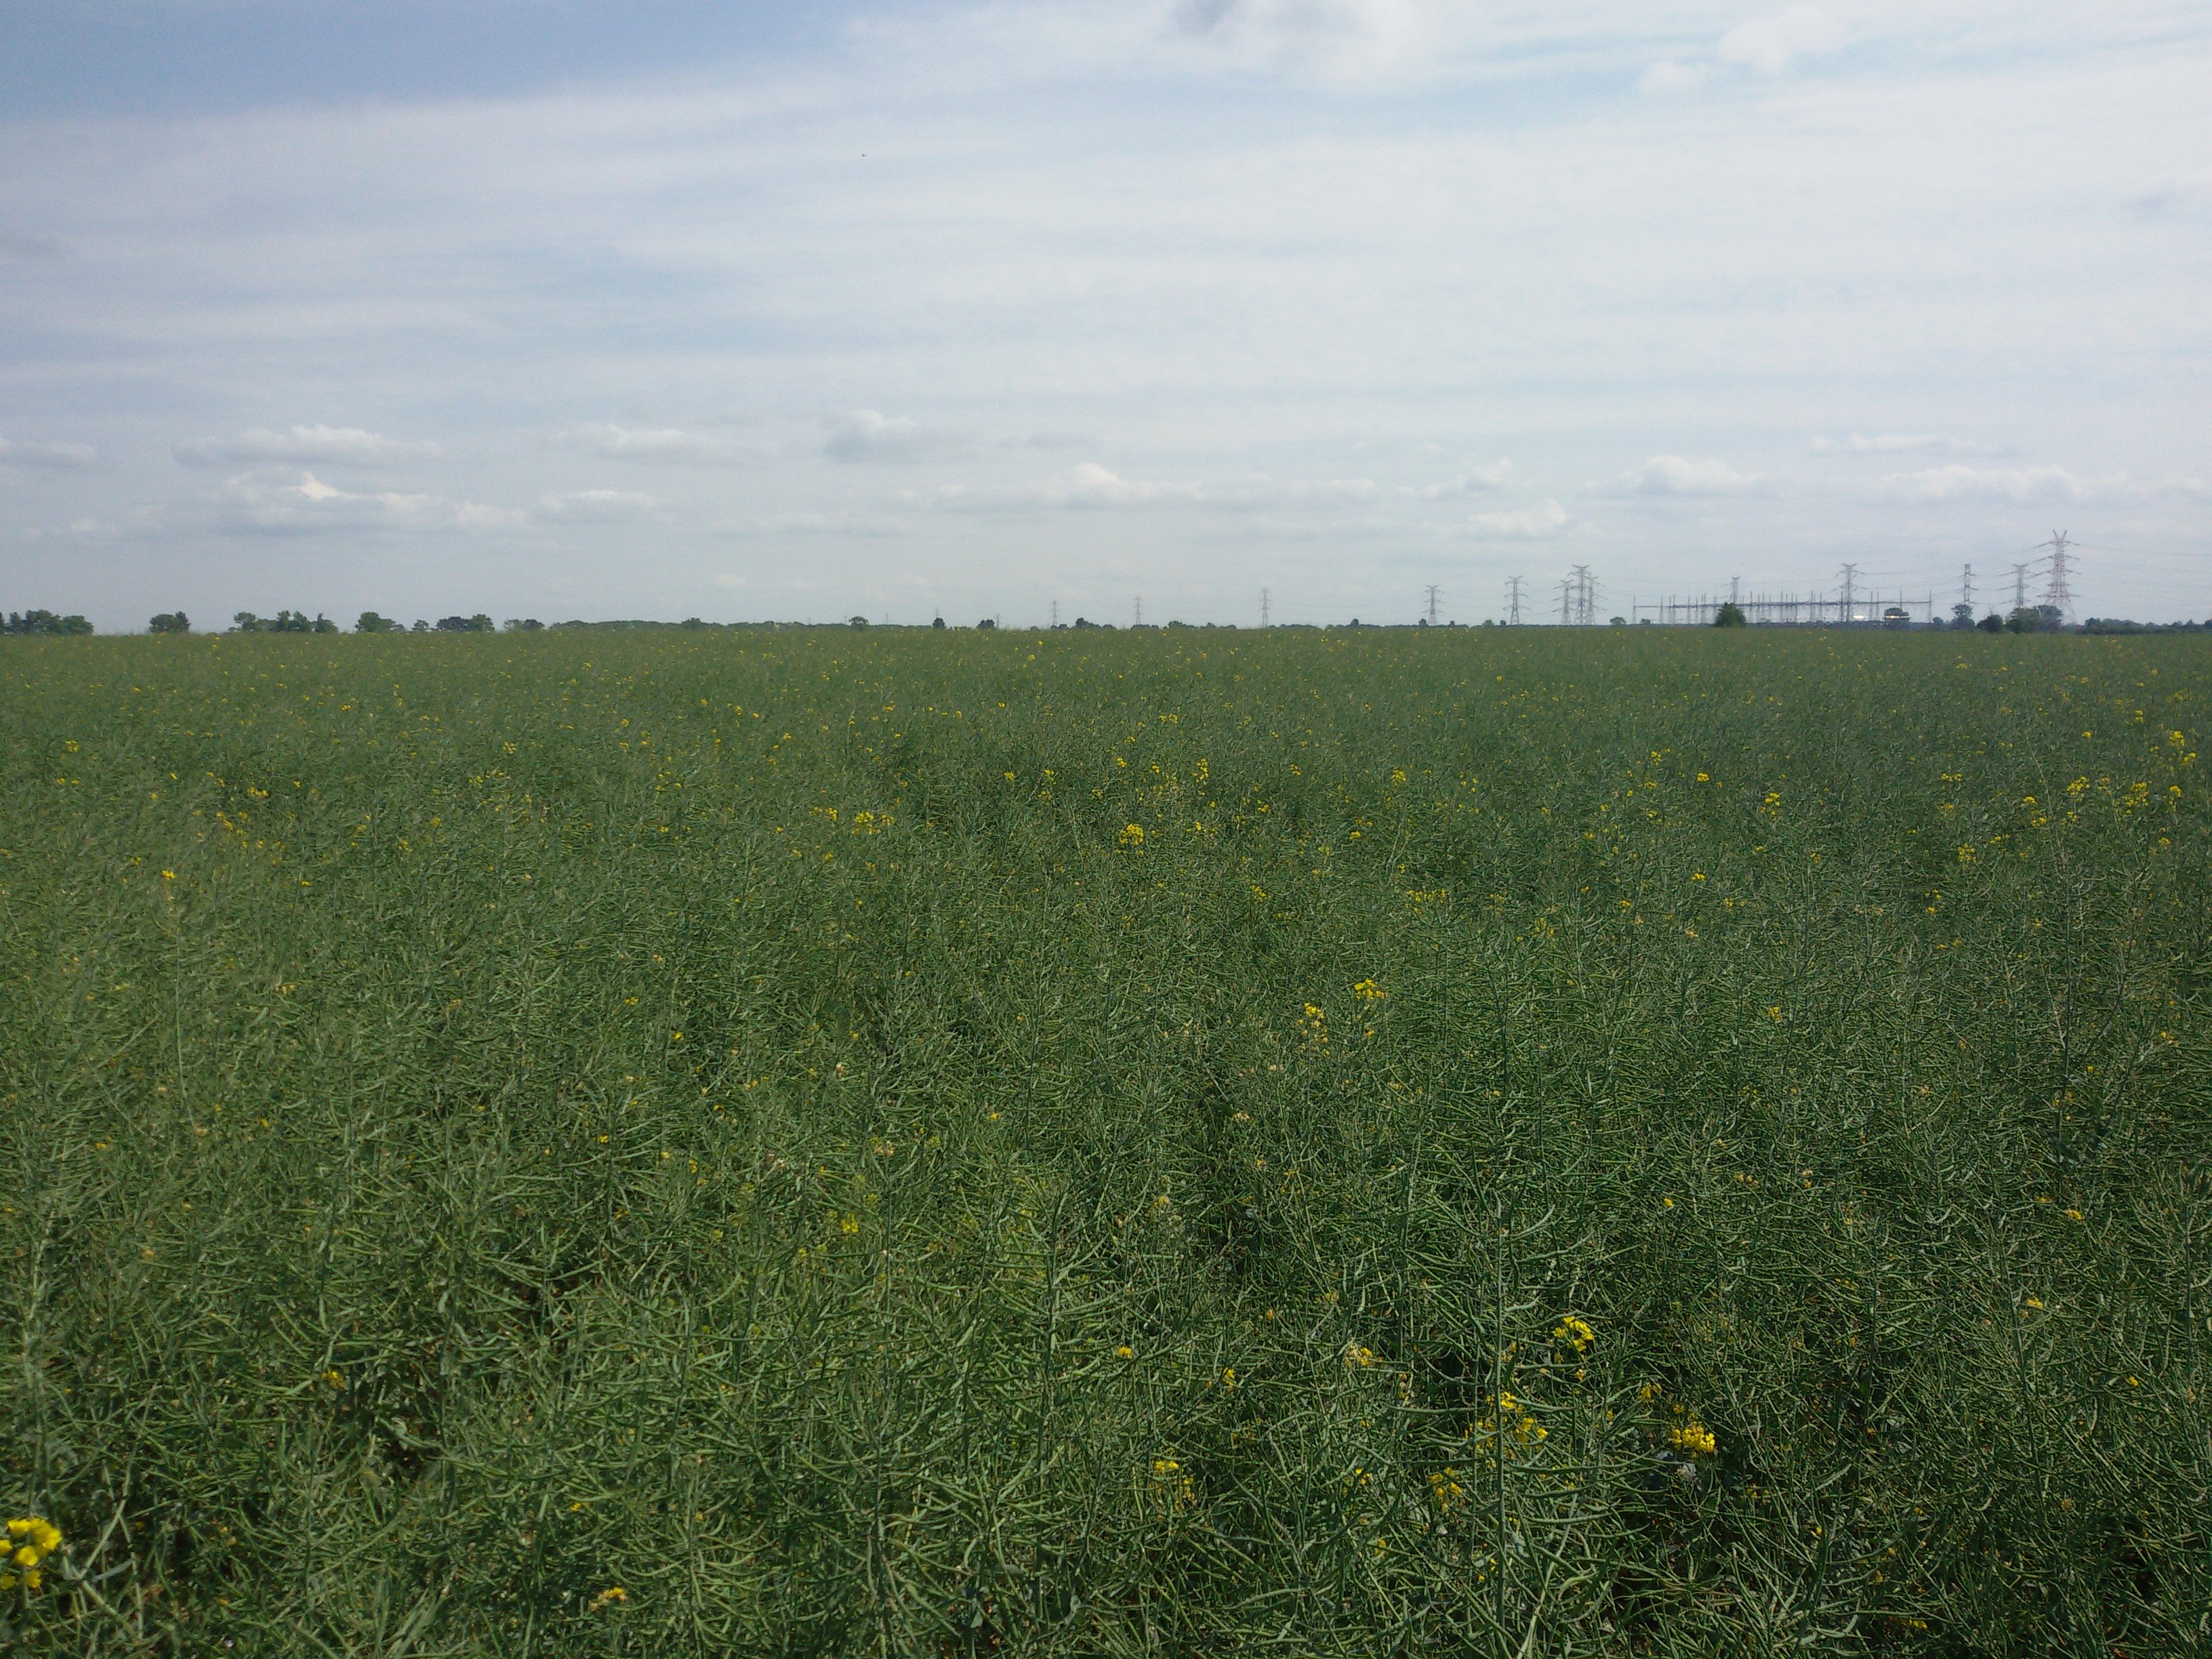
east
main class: Cropland
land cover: Rape and turnip rape
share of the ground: > 75 %
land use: Agriculture (excluding fallow land and kitchen gardens)
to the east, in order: Rape and turnip rape
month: May
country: PL
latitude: 52.2881
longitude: 17.1502
